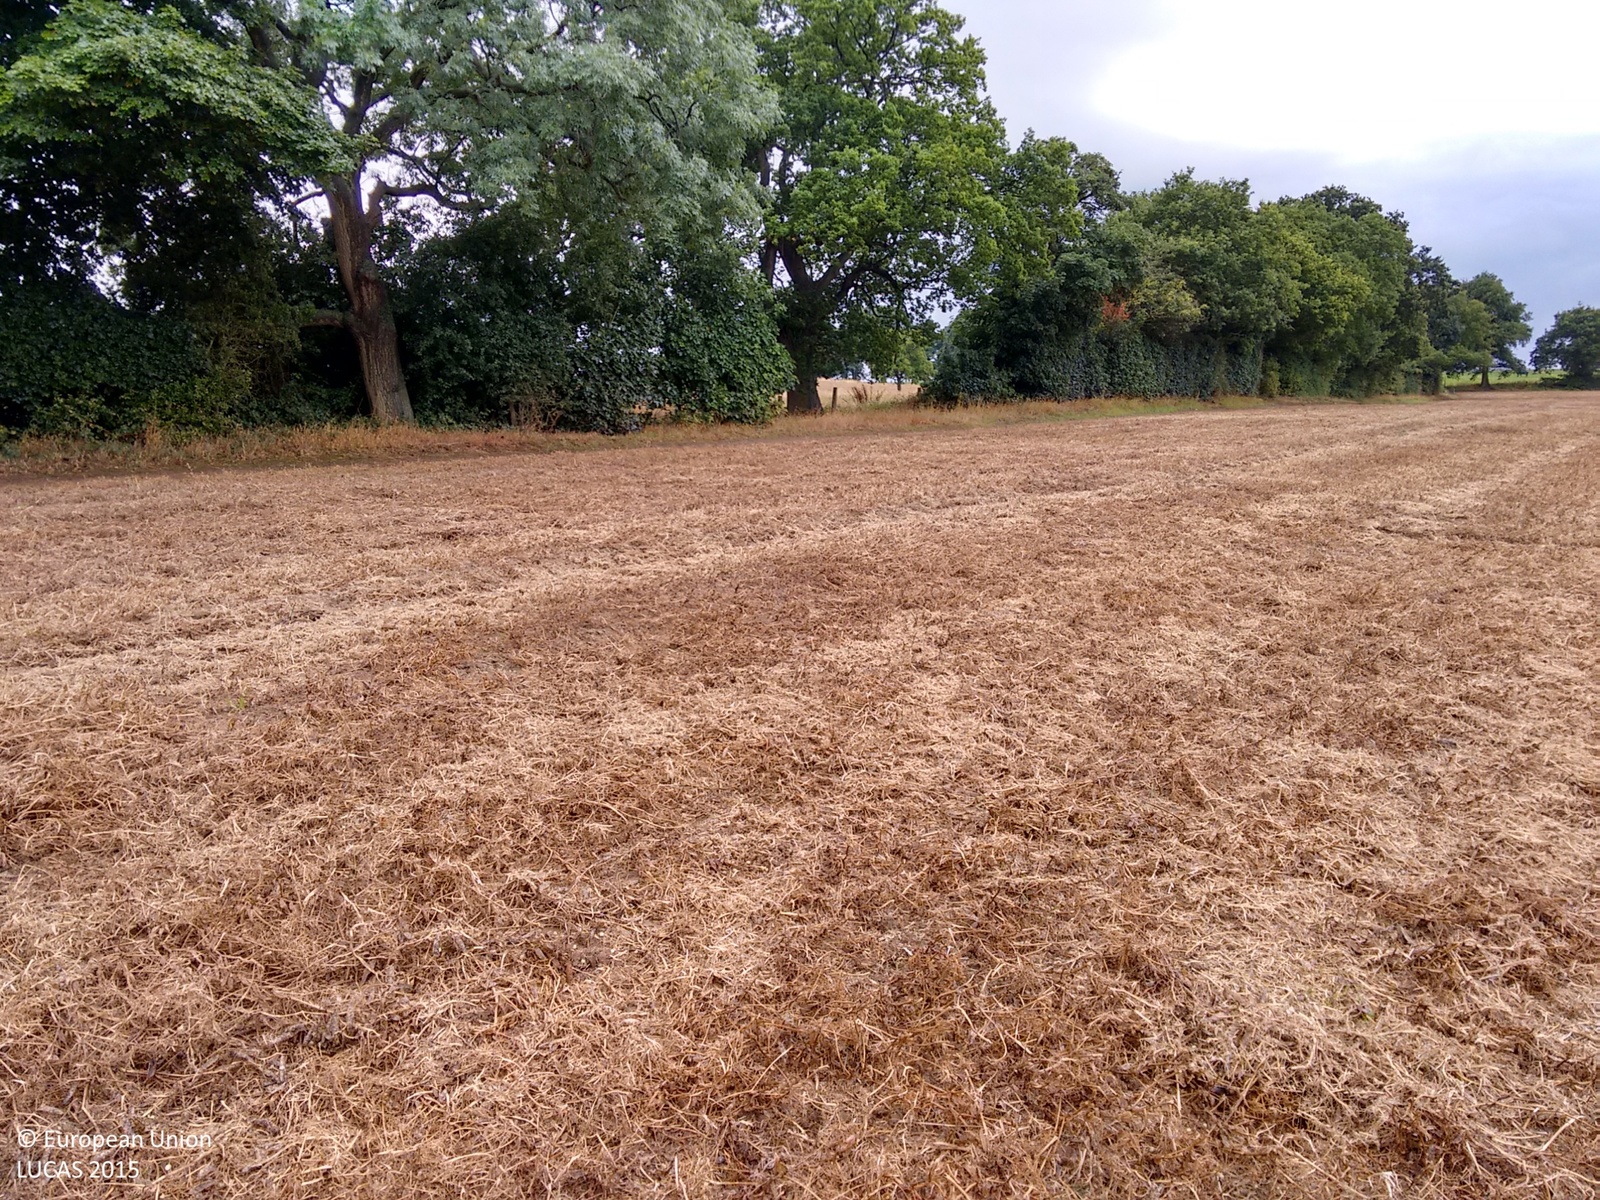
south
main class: Cropland
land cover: Dry pulses
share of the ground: > 75 %
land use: Agriculture (excluding fallow land and kitchen gardens)
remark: Harvested field
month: September
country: GB
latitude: 52.7662
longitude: -1.4470
